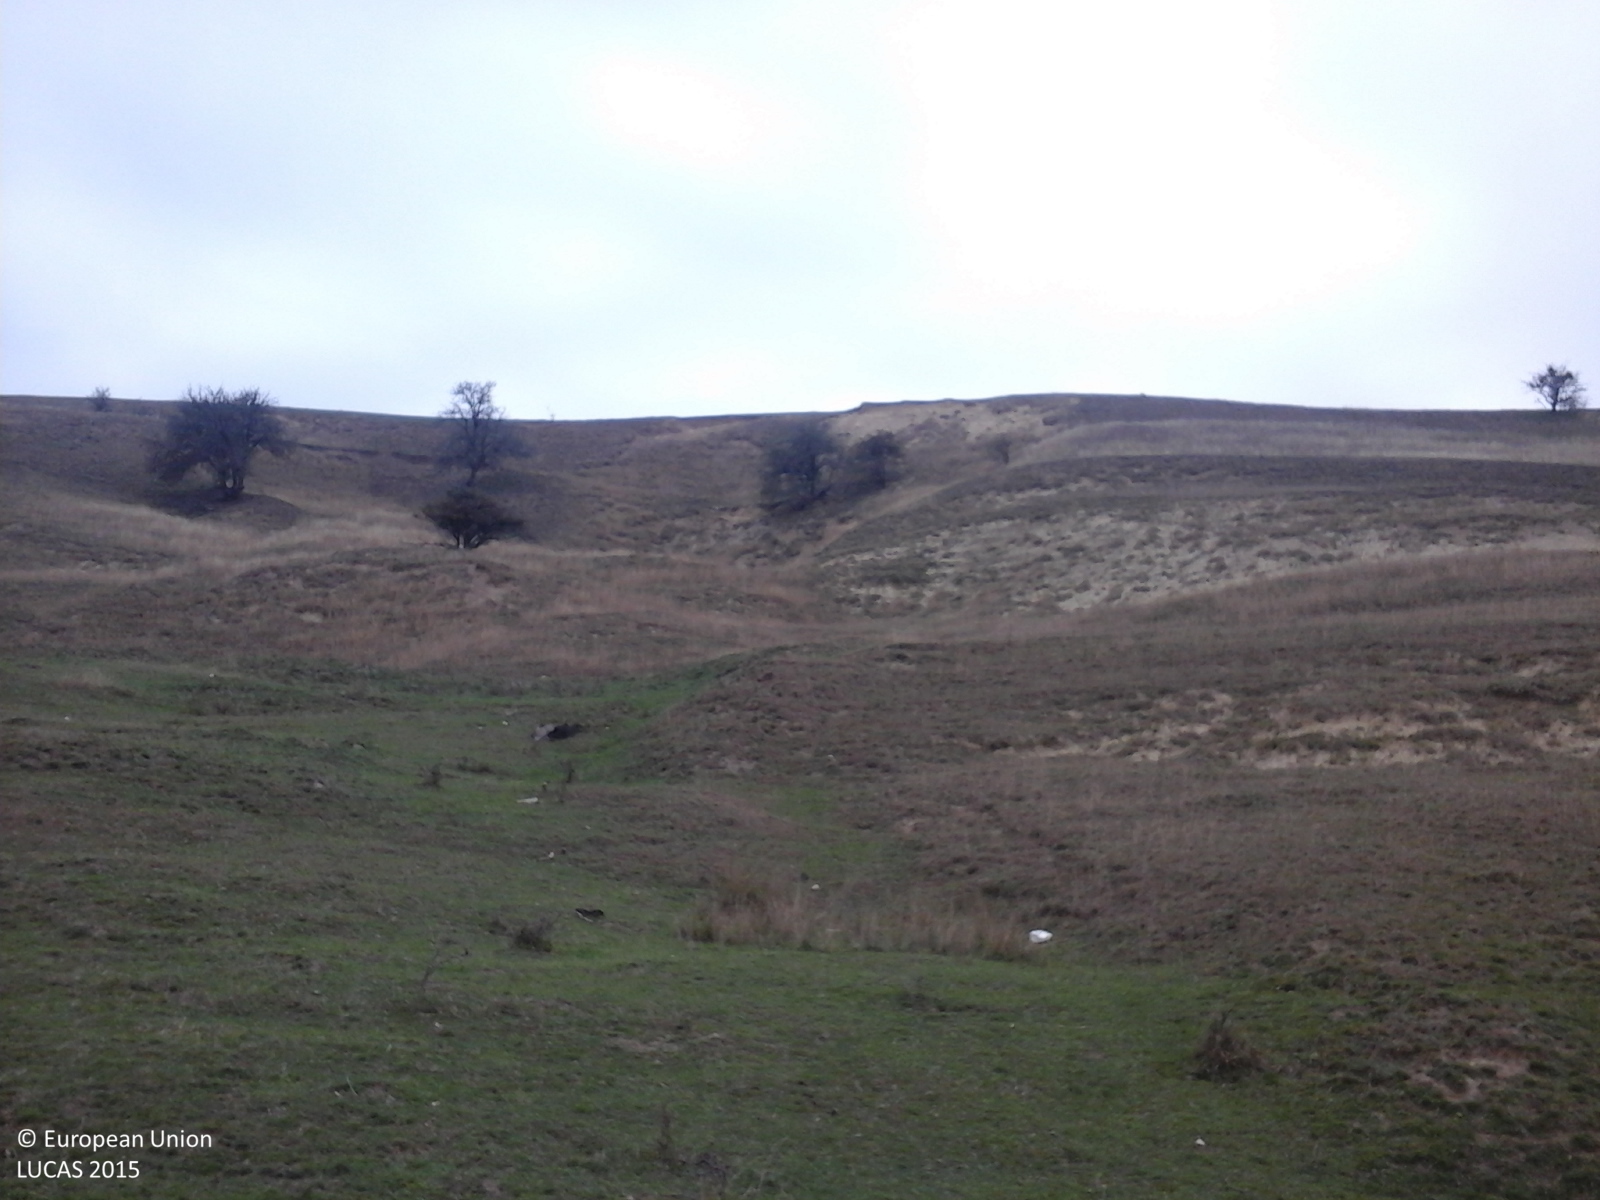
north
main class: Grassland
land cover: Grassland without tree/shrub cover
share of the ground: > 75 %
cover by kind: herbaceous plants 100 %
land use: Agriculture (excluding fallow land and kitchen gardens)
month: October
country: RO
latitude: 46.0196
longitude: 25.1189
